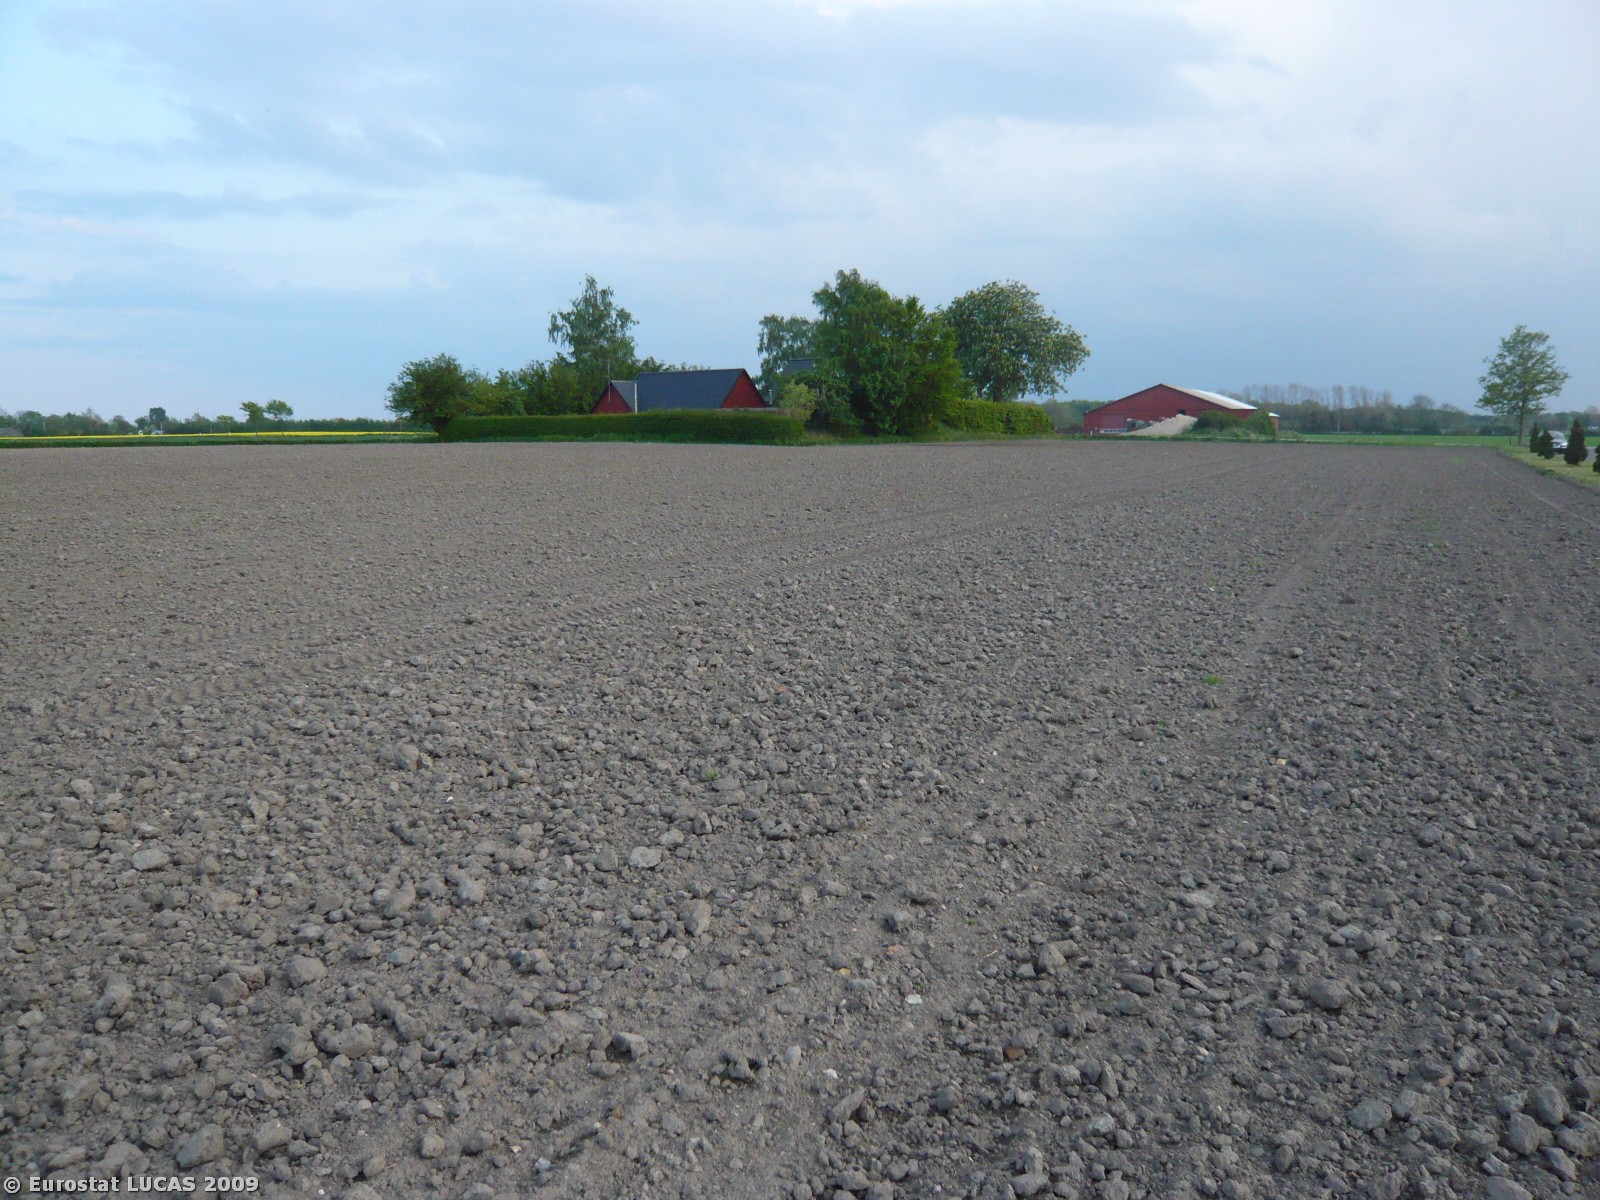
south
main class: Cropland
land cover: Other root crops
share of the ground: < 10 %
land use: Agriculture (excluding fallow land and kitchen gardens)
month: May
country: DK
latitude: 55.3223
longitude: 12.2835
